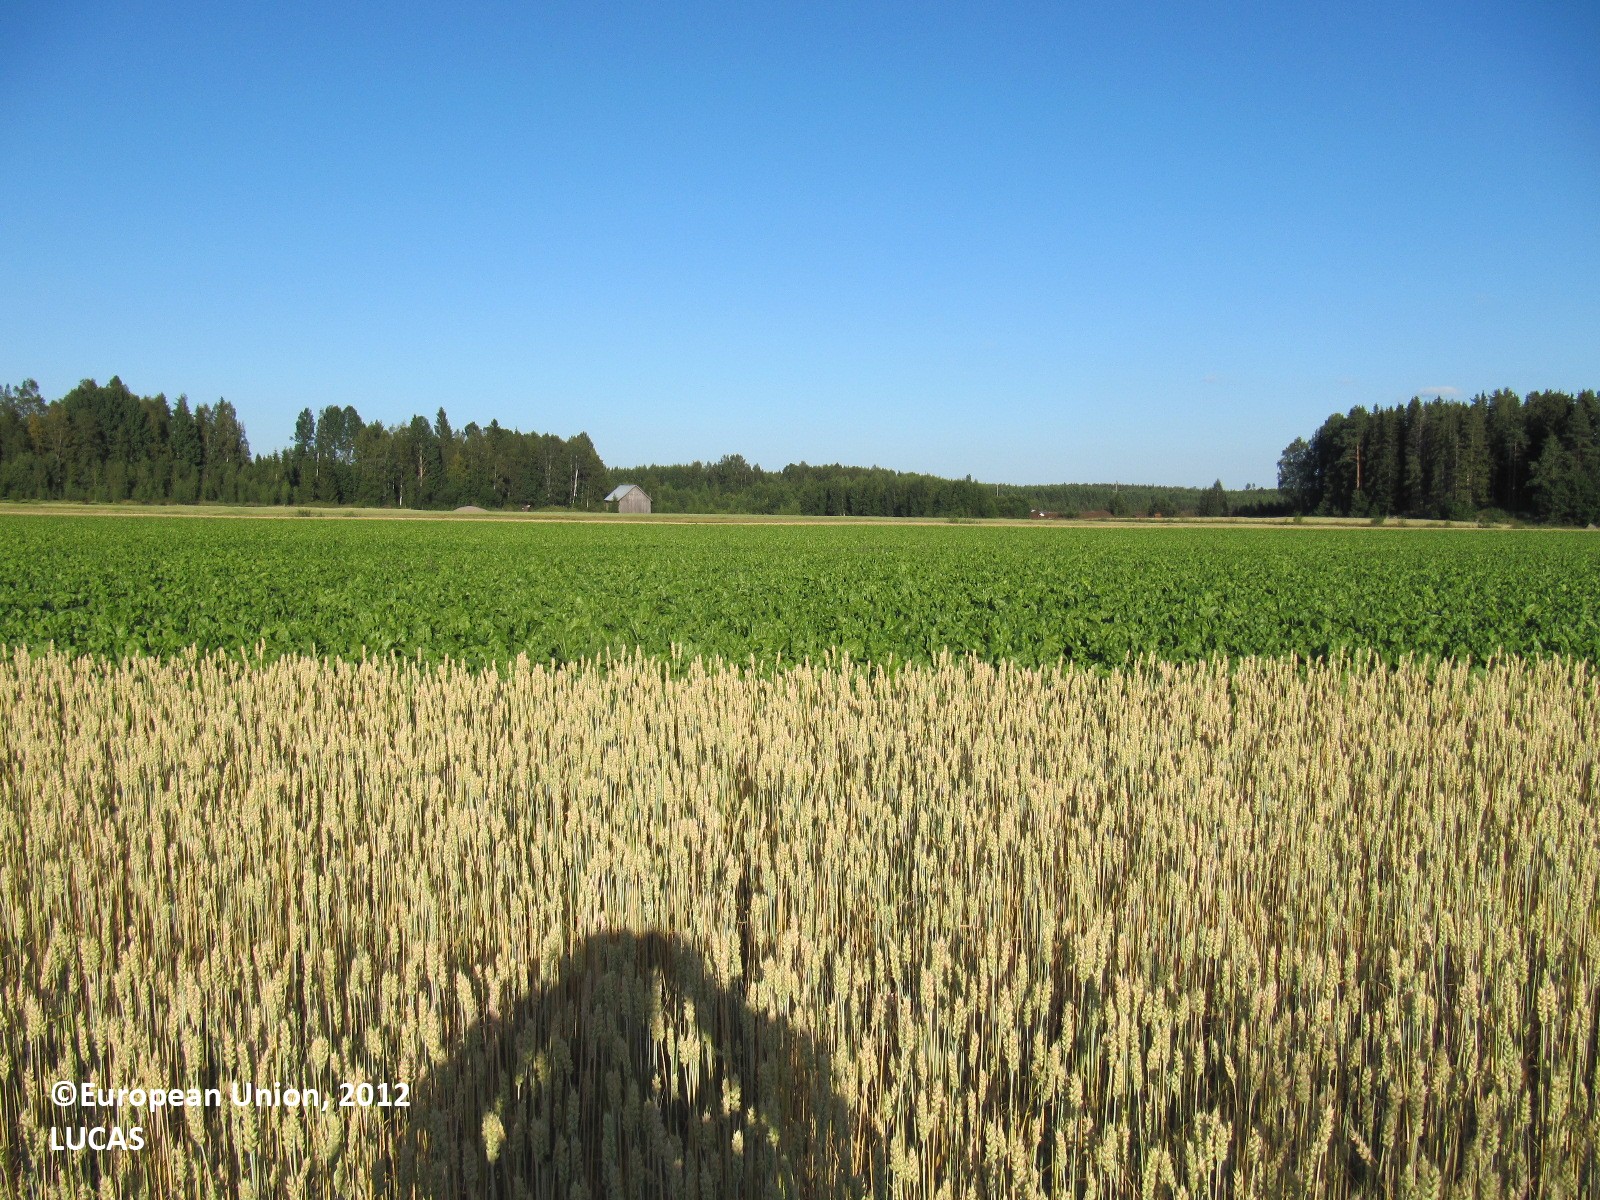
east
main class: Cropland
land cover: Common wheat
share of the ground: > 75 %
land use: Agriculture (excluding fallow land and kitchen gardens)
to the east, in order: Common wheat; Sugar beet; Common wheat; Grass margins; Ditches and canals; Grass margins; Common wheat
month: August
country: FI
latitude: 60.6729
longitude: 24.5097
